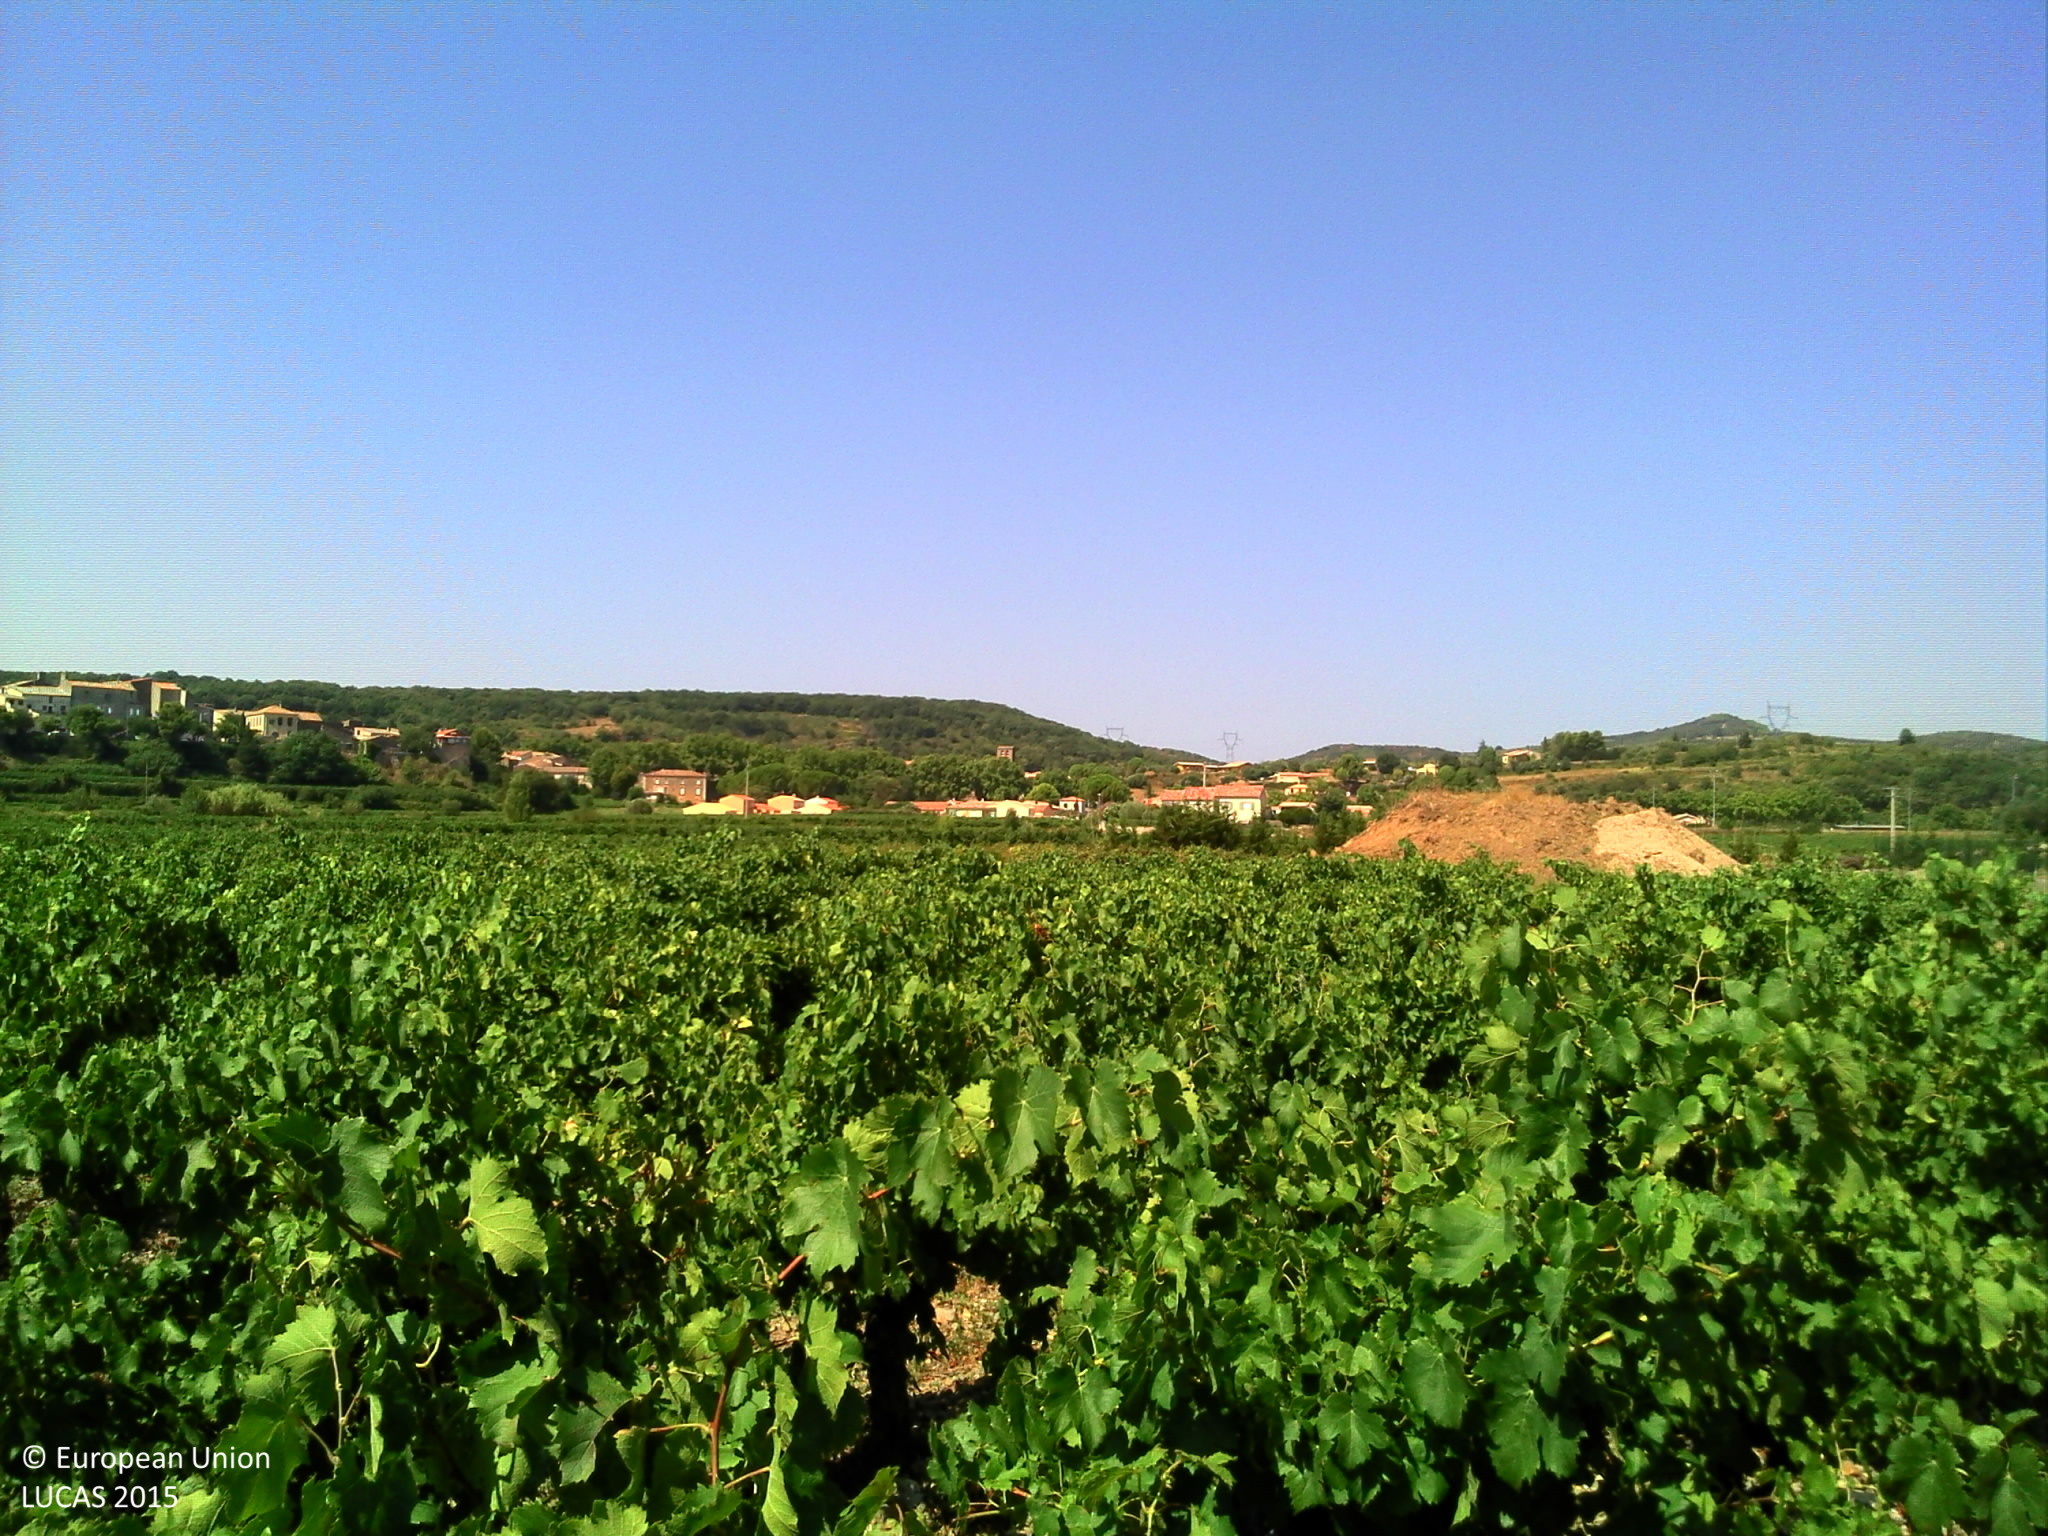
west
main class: Cropland
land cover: Vineyards
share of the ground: 10 - 25 %
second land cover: Other bare soil
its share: > 75 %
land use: Agriculture (excluding fallow land and kitchen gardens)
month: August
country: FR
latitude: 43.5424
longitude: 3.3876
